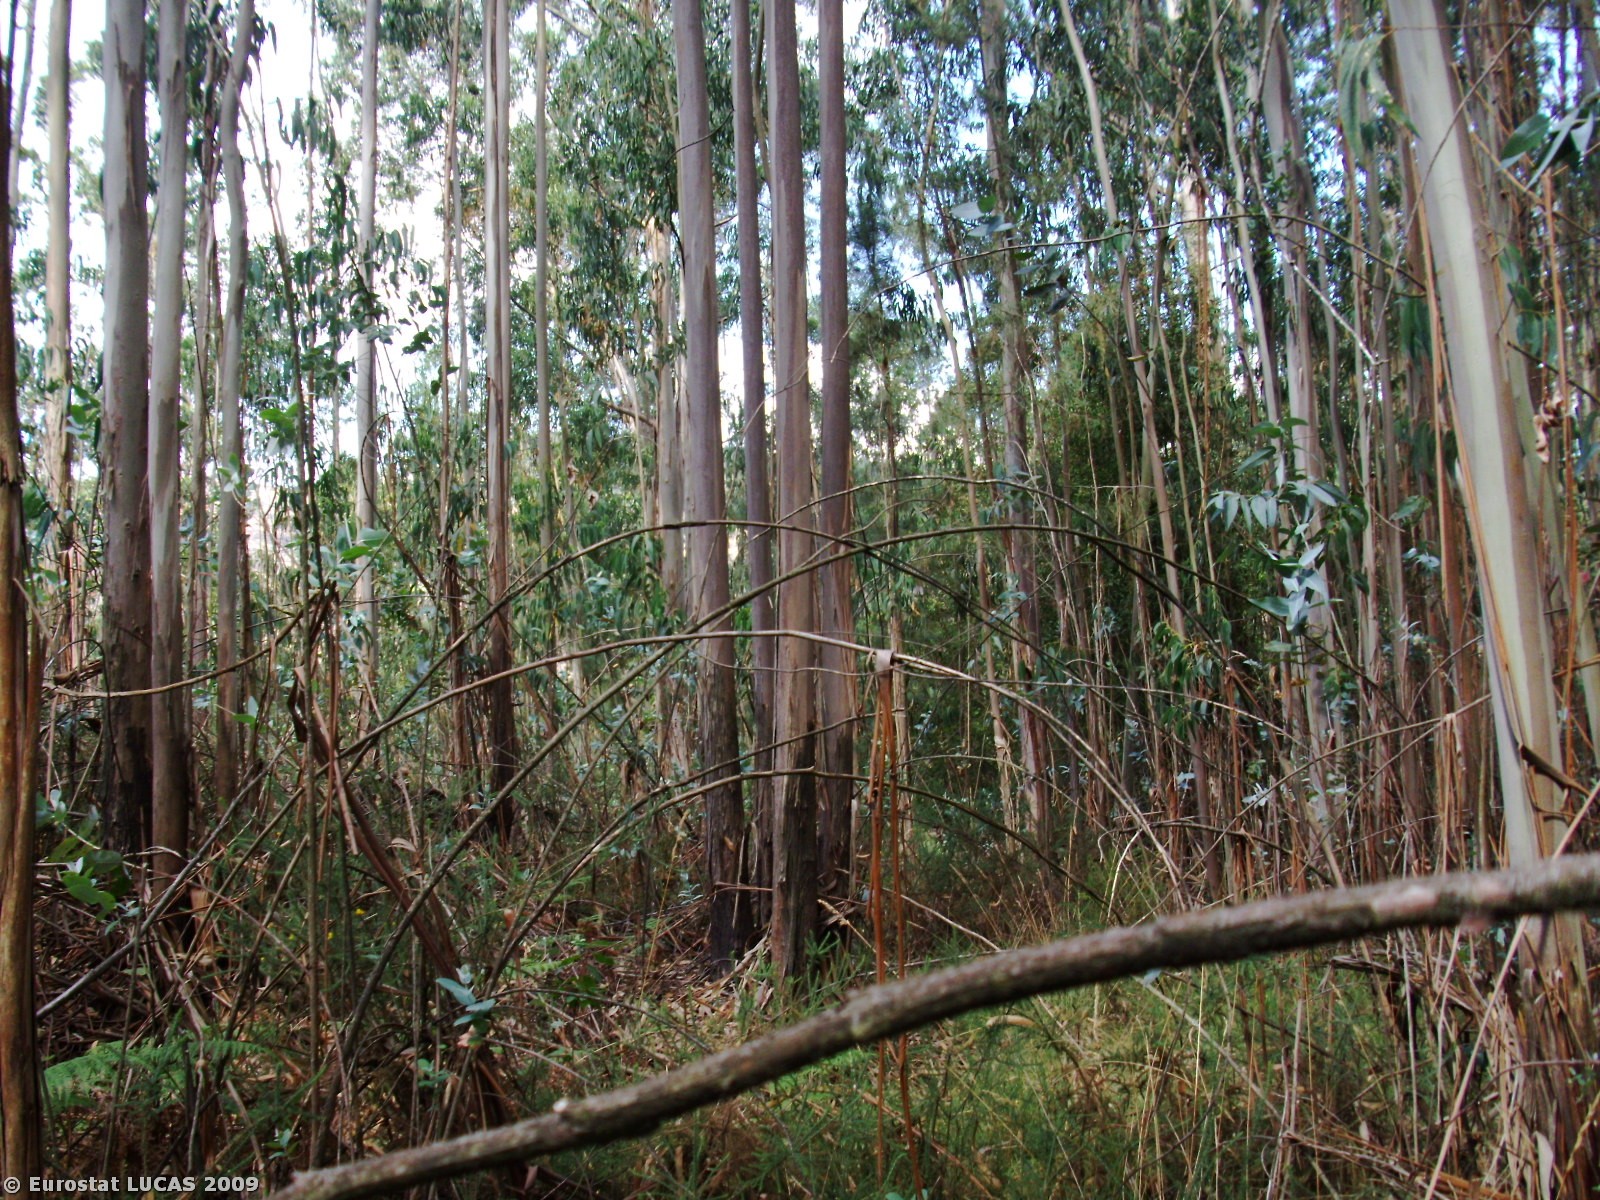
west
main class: Woodland
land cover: Broadleaved woodland
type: plantations and self-sown exotic forest
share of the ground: 50 - 75 %
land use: Forestry
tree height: > 5 m
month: July
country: PT
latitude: 41.2128
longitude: -8.4816
